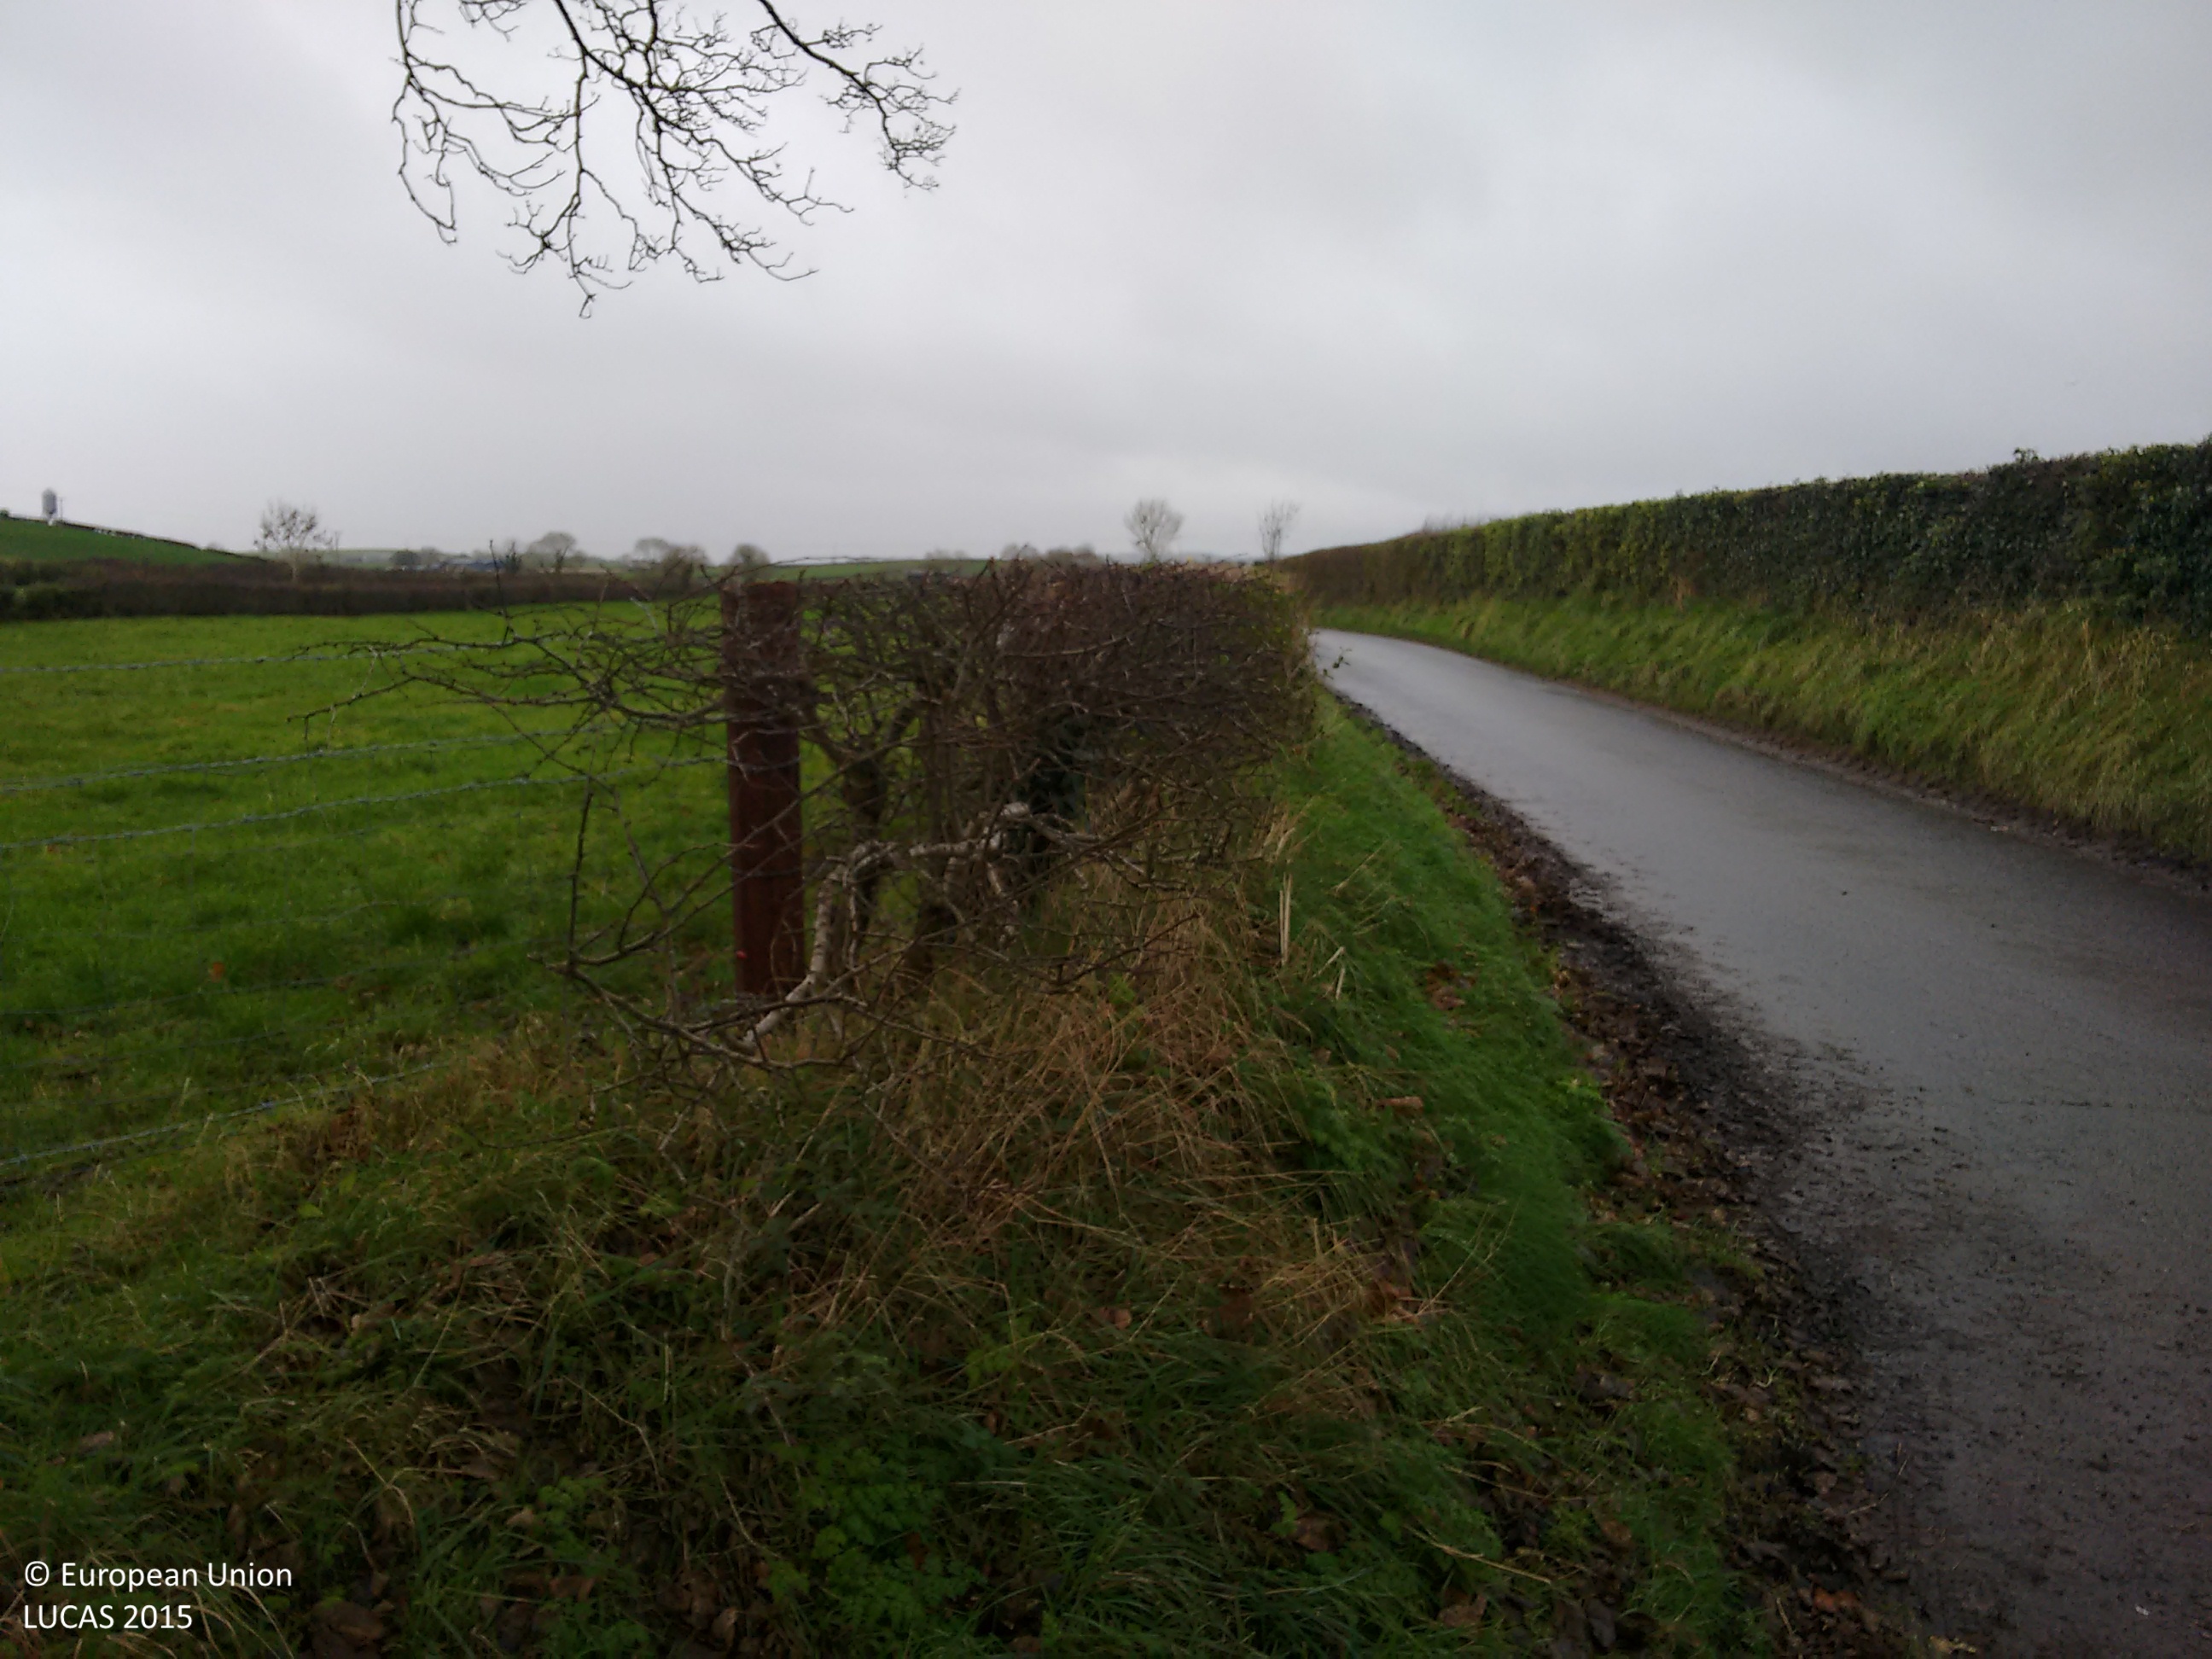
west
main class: Grassland
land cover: Grassland with sparse tree/shrub cover
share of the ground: > 75 %
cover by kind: herbaceous plants 95 %, broadleaved forest trees 5 %
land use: Fallow land
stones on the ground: > 50 %
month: November
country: GB
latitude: 54.6154
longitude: -5.6311
